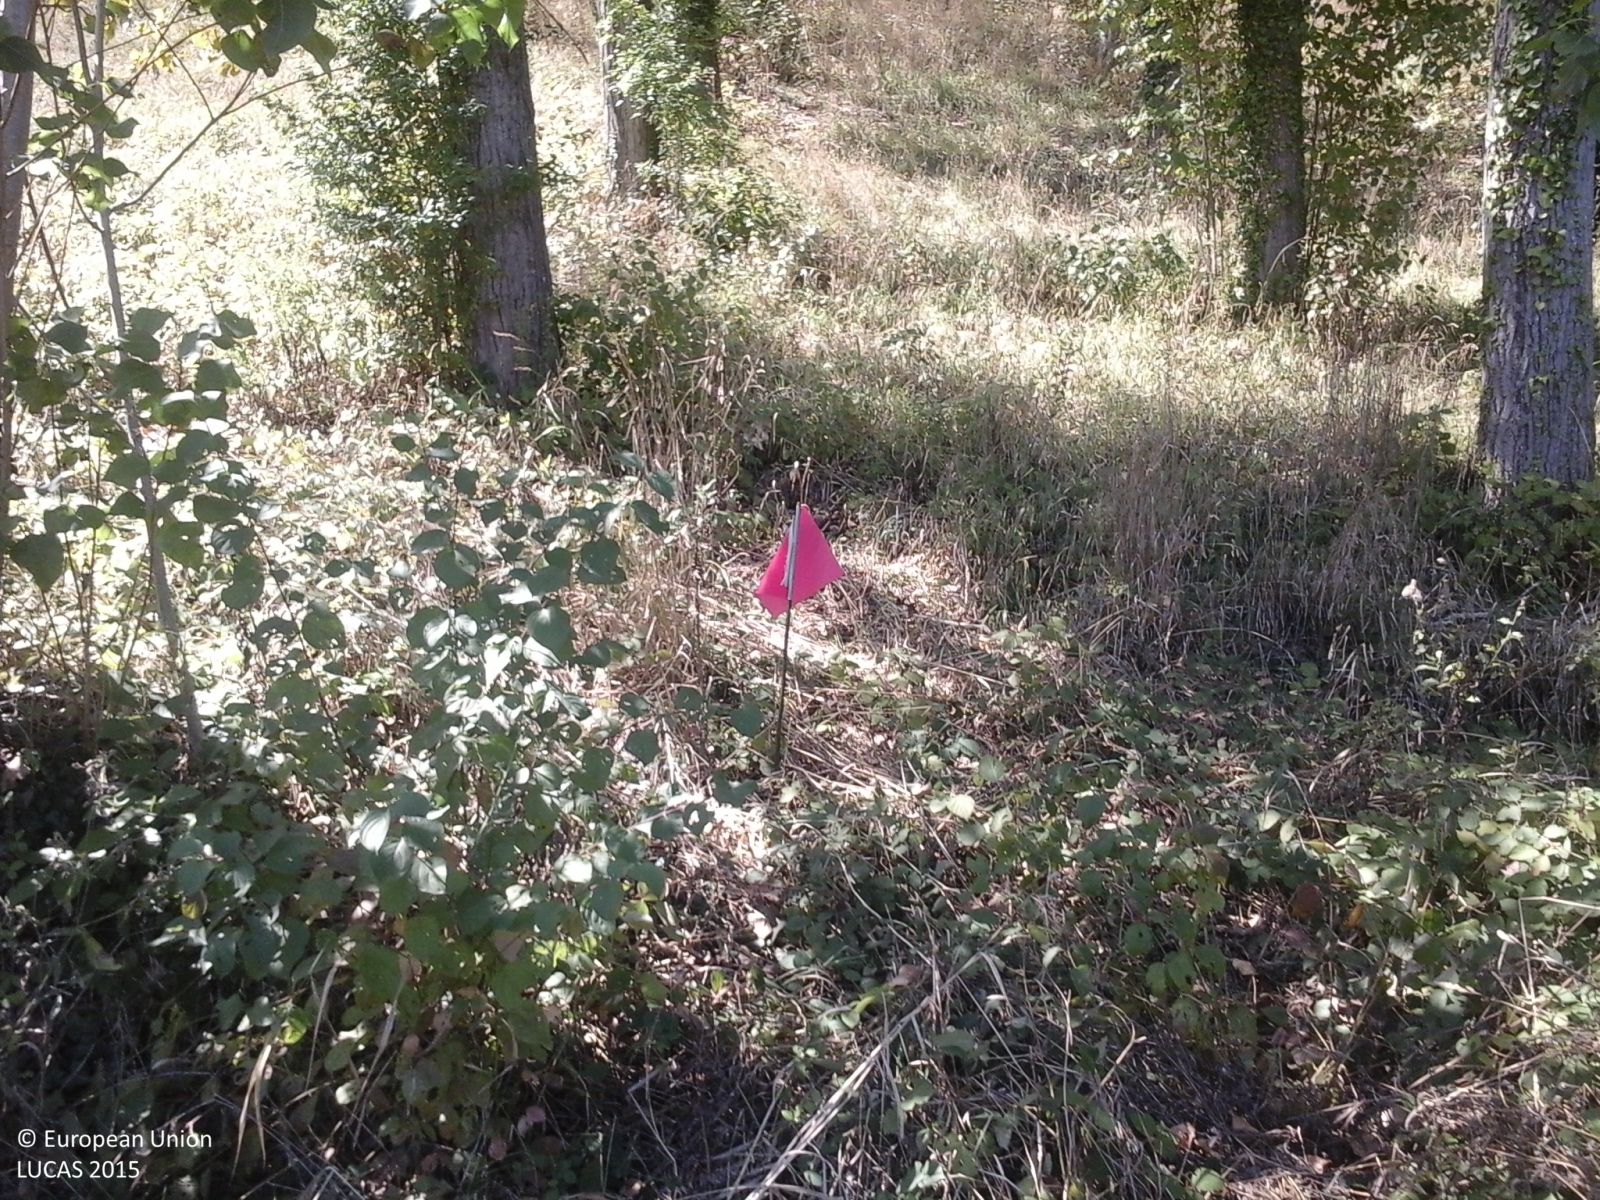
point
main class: Woodland
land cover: Broadleaved woodland
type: thermophilous deciduous forest
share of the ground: > 75 %
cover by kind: broadleaved forest trees 100 %
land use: Forestry
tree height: > 5 m
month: September
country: IT
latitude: 43.7248
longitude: 13.1580
